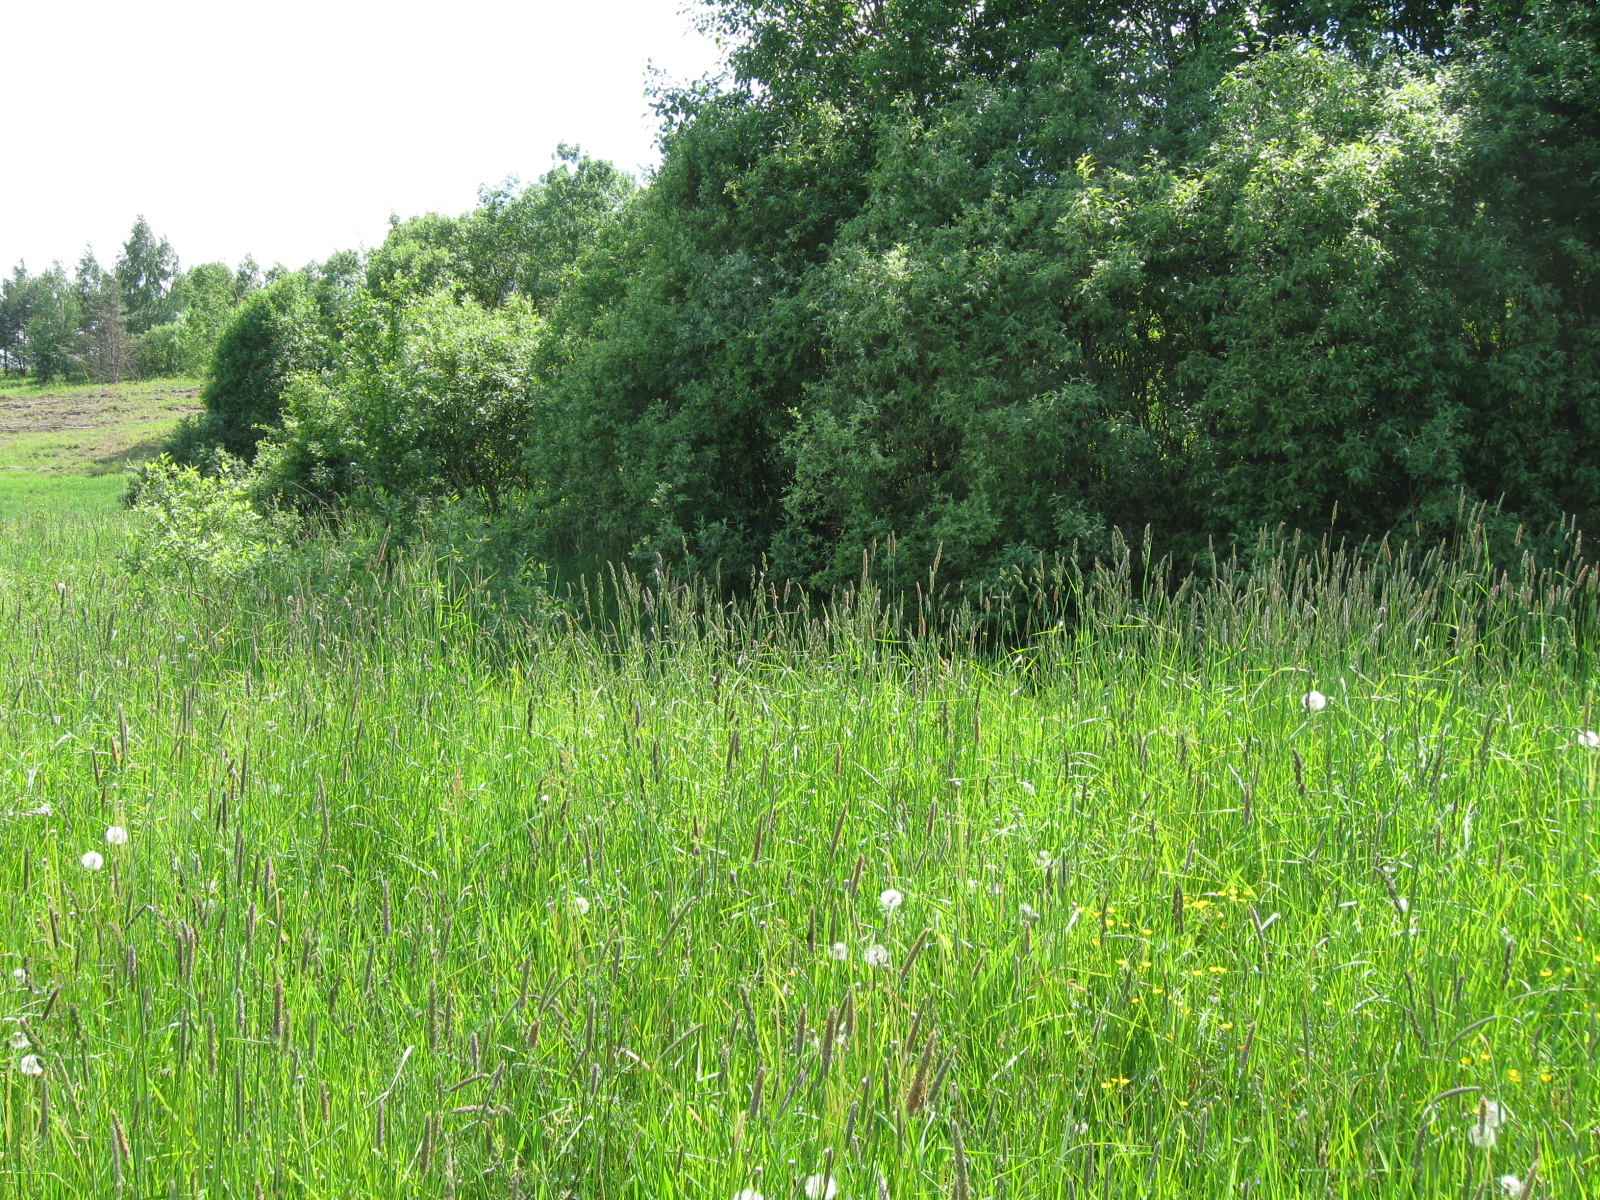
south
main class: Grassland
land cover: Grassland without tree/shrub cover
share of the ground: > 75 %
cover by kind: herbaceous plants 100 %
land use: Agriculture (excluding fallow land and kitchen gardens)
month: June
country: LT
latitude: 54.2330
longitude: 23.7882
